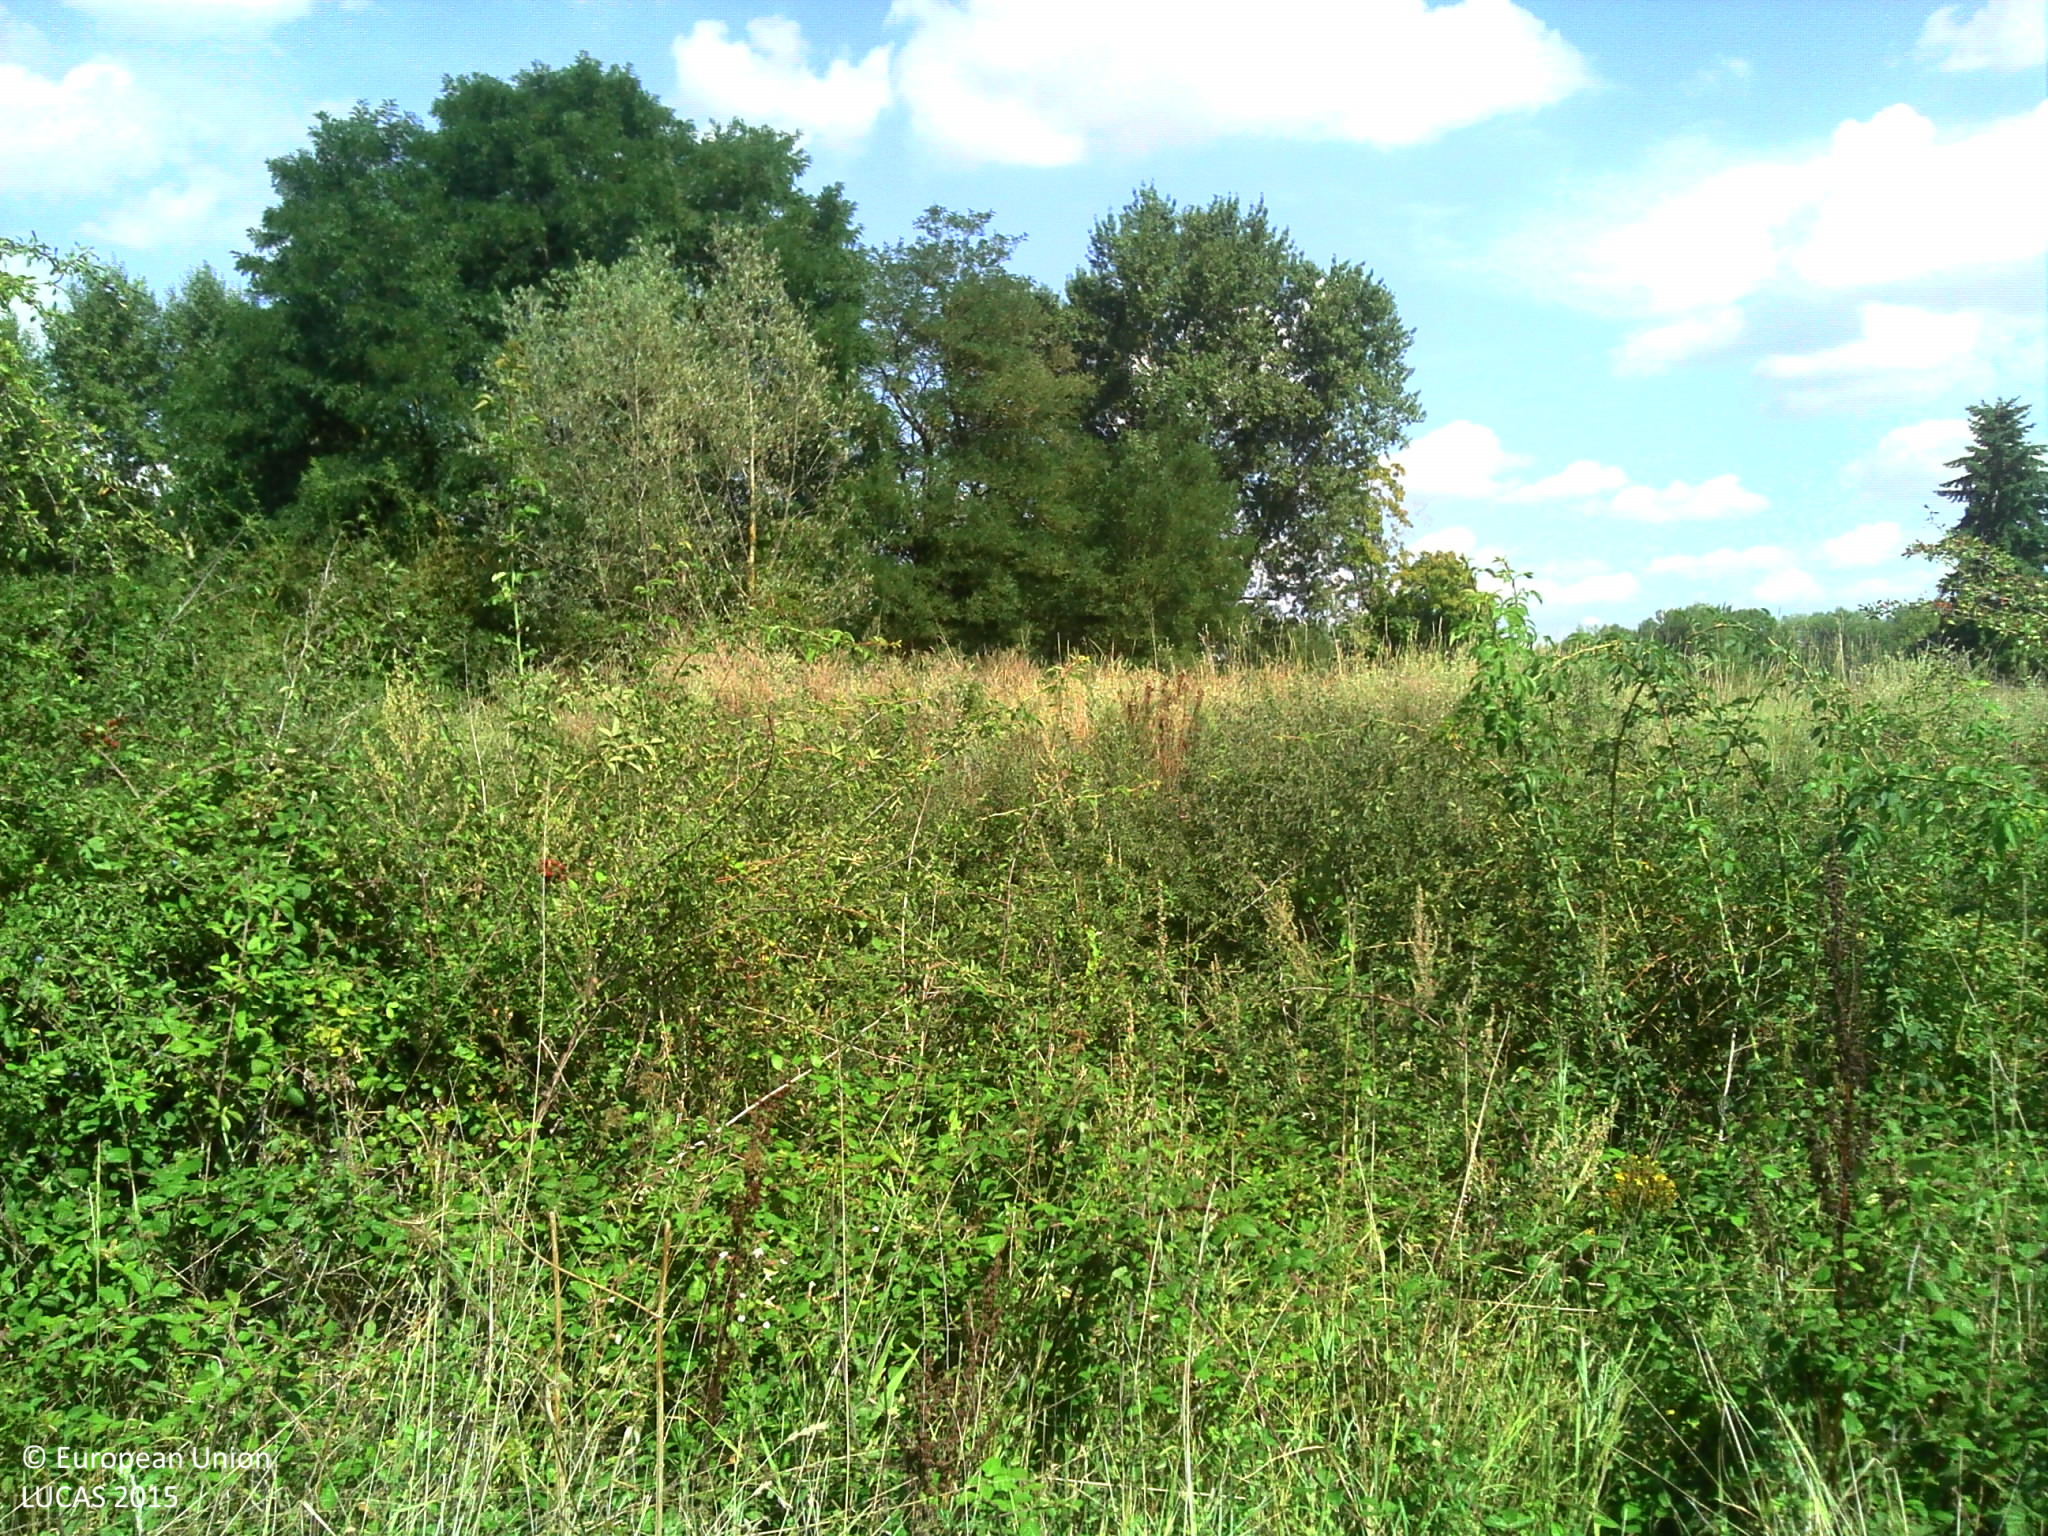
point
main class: Grassland
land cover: Spontaneously vegetated surfaces
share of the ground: > 75 %
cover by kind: herbaceous plants 95 %, shrubs 5 %
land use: Semi-natural and natural areas not in use
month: August
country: FR
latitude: 46.5750
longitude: 3.3043
